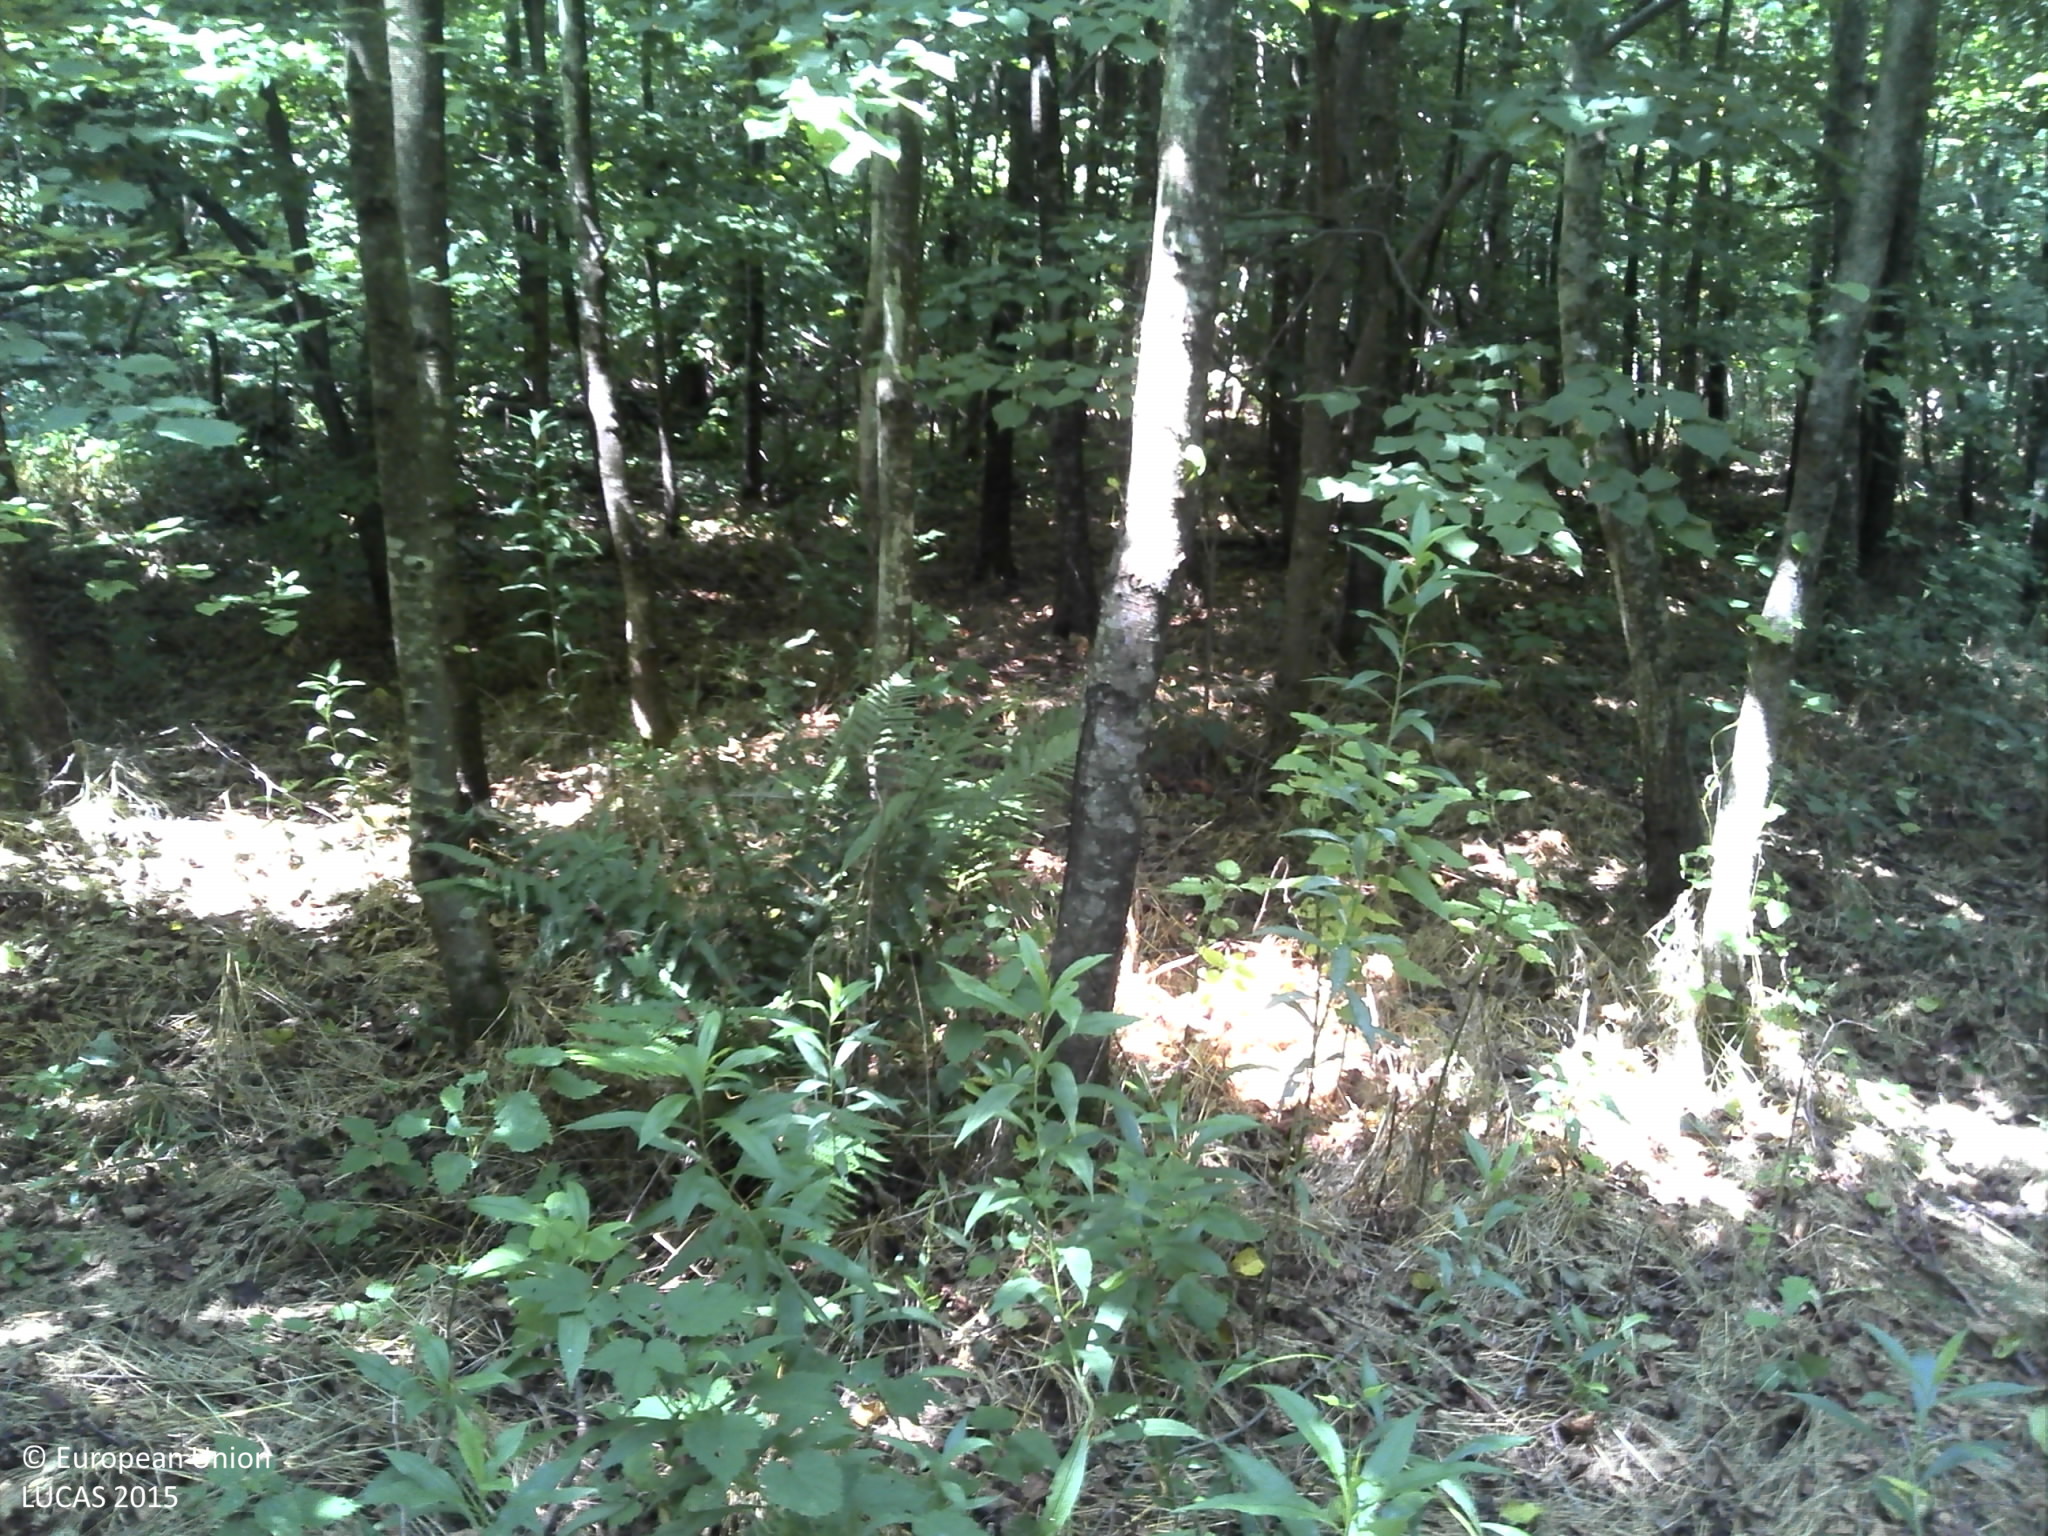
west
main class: Woodland
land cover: Broadleaved woodland
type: non-riverine alder, birch or aspen forest
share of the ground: > 75 %
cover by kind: broadleaved forest trees 90 %, shrubs 5 %, herbaceous plants 5 %
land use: Forestry
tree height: > 5 m
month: July
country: HR
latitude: 45.7681
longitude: 16.5959
